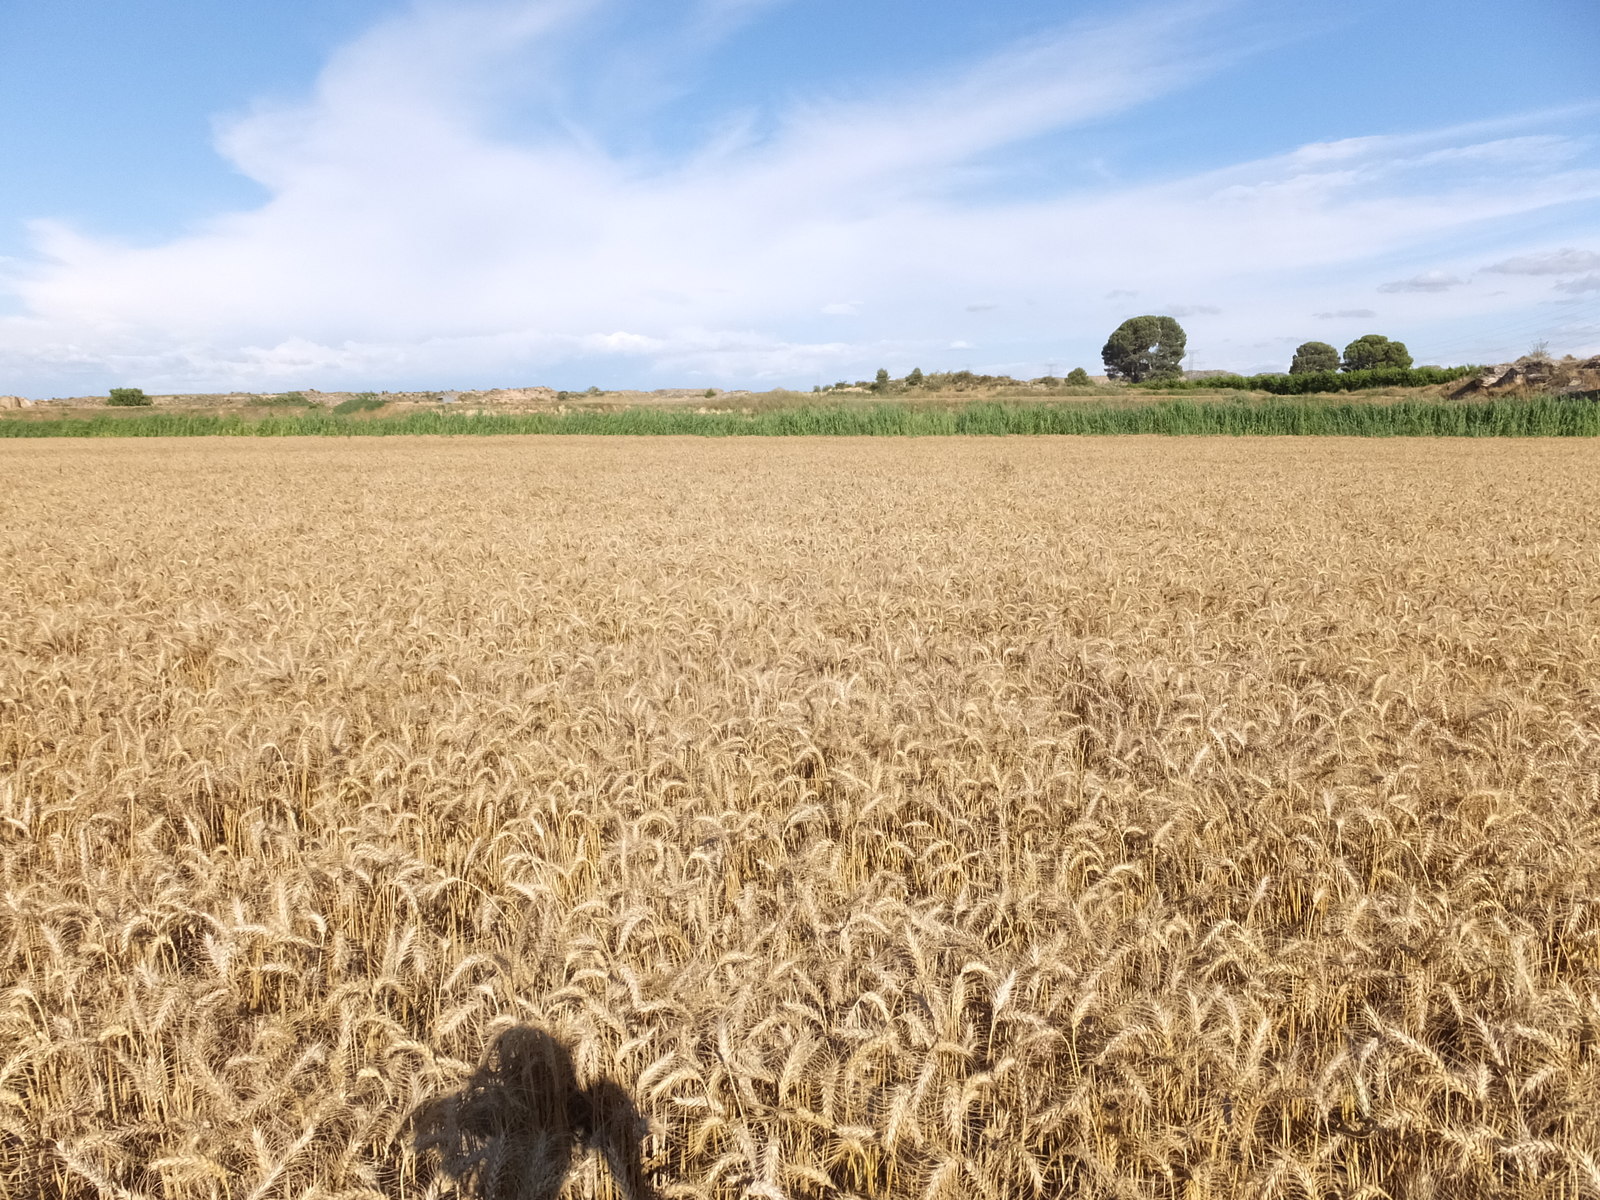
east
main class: Cropland
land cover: Durum wheat
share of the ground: > 75 %
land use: Agriculture (excluding fallow land and kitchen gardens)
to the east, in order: Durum wheat; Shruby margins; Common wheat; Shruby margins; Common wheat; Shruby margins; Ditches and canals; Grassland without tree/shrub cover; Tracks; Grass margins; Nuts trees
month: June
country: ES
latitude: 41.2184
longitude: -0.1158
